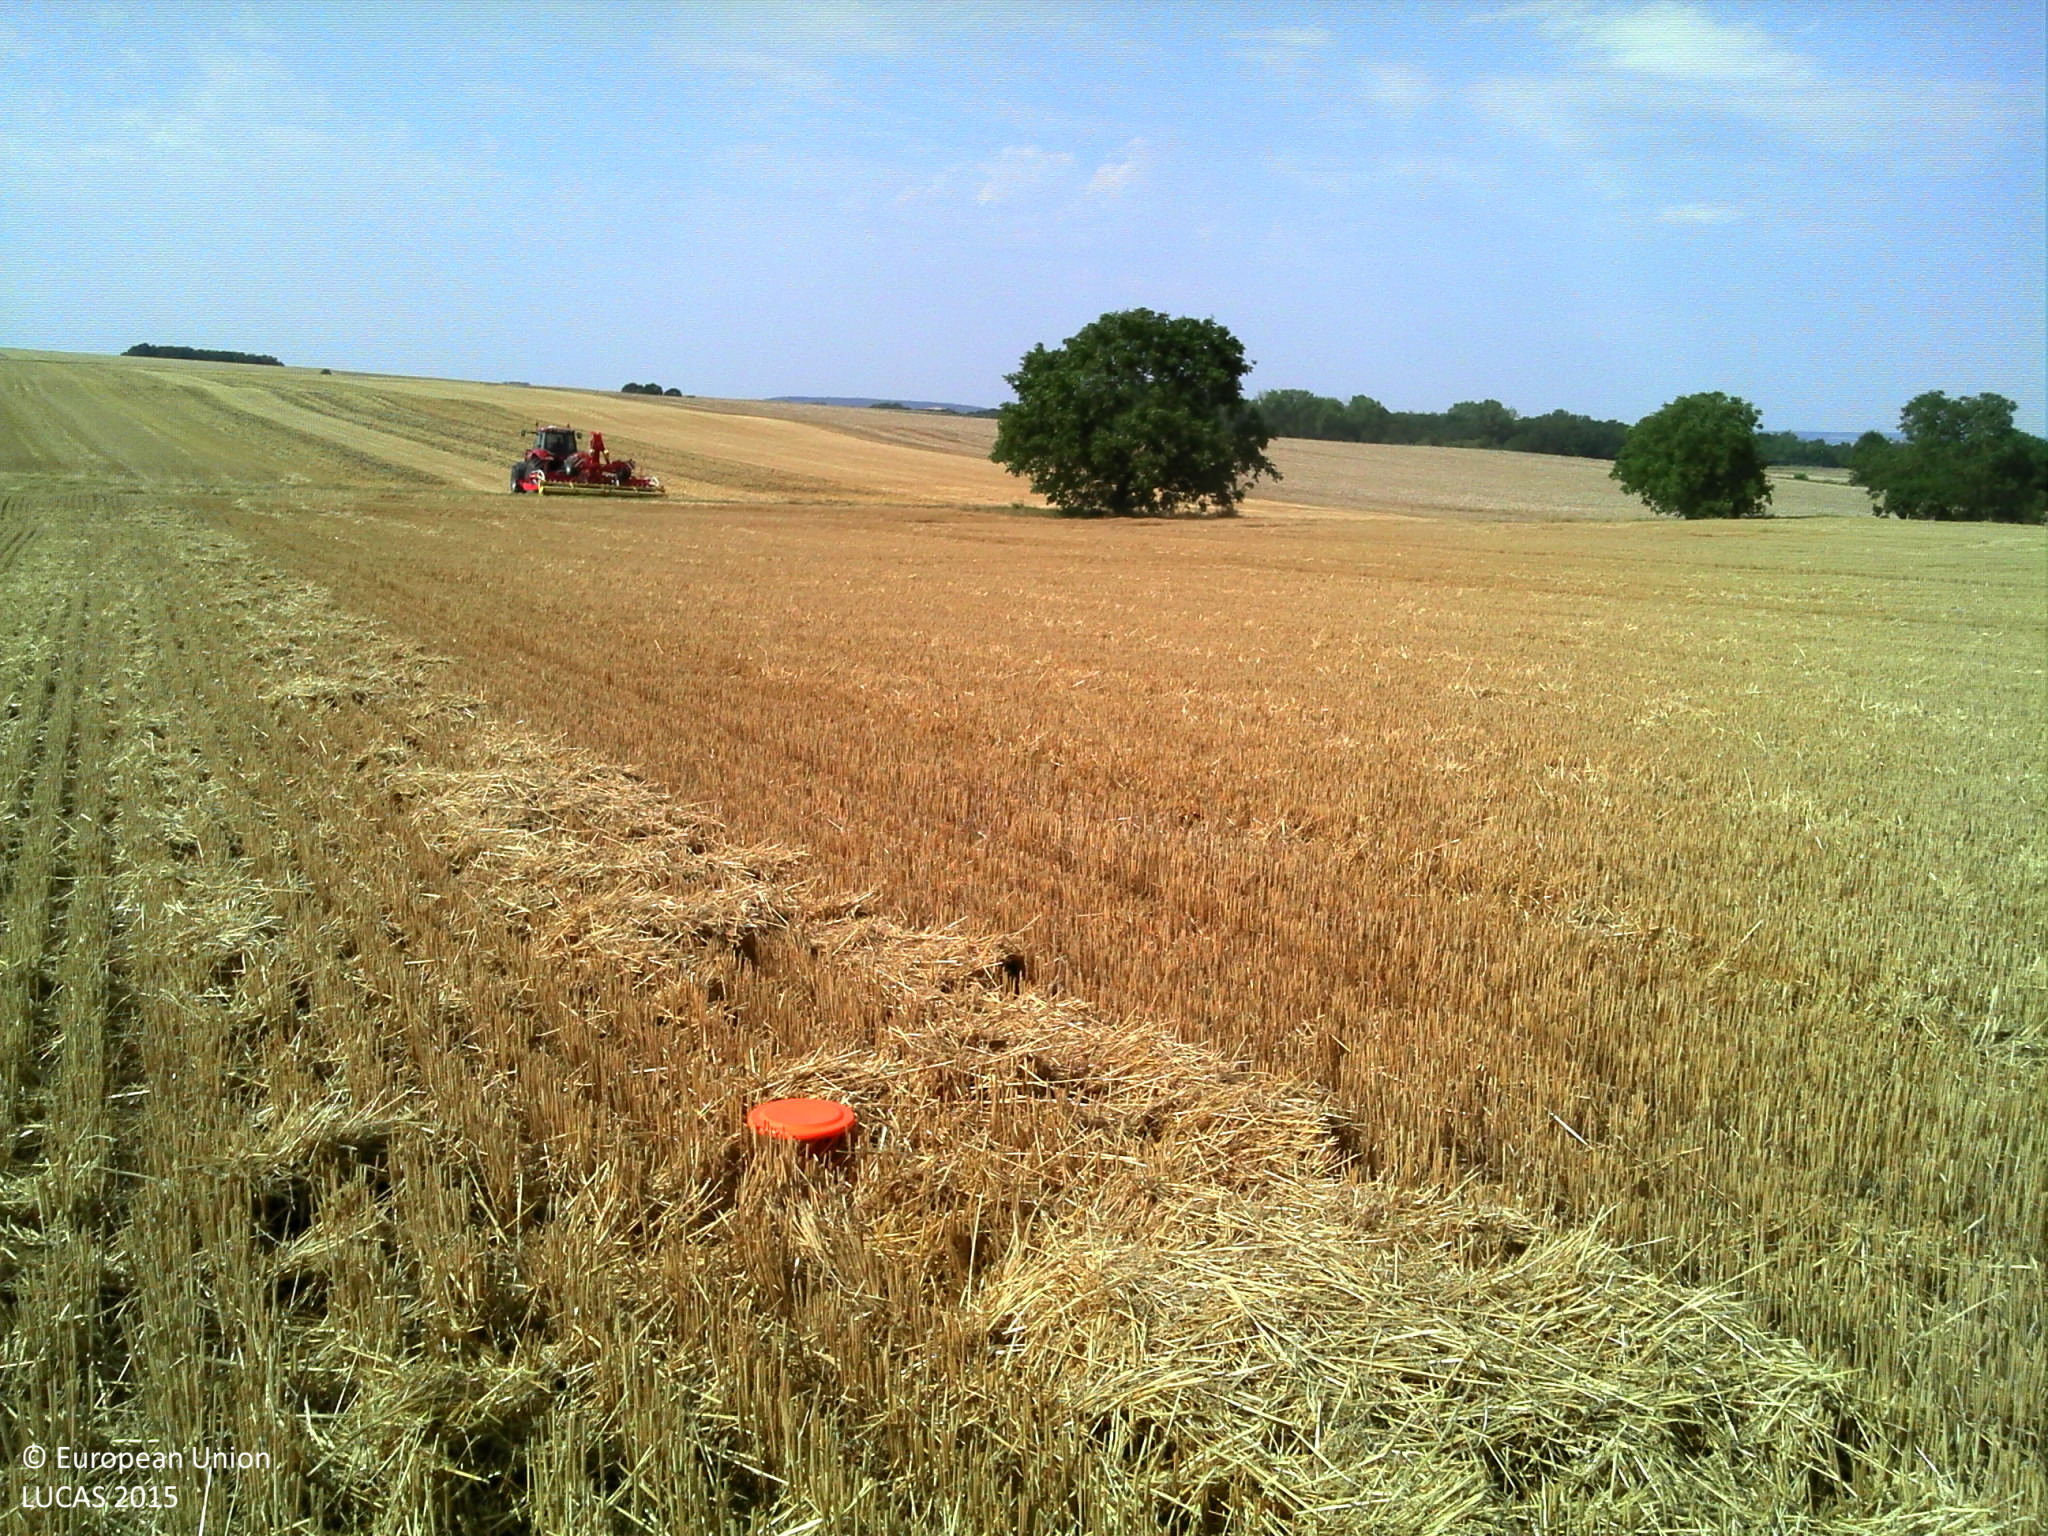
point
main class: Cropland
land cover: Common wheat
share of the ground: > 75 %
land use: Agriculture (excluding fallow land and kitchen gardens)
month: August
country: FR
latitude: 47.8472
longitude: 3.4337
